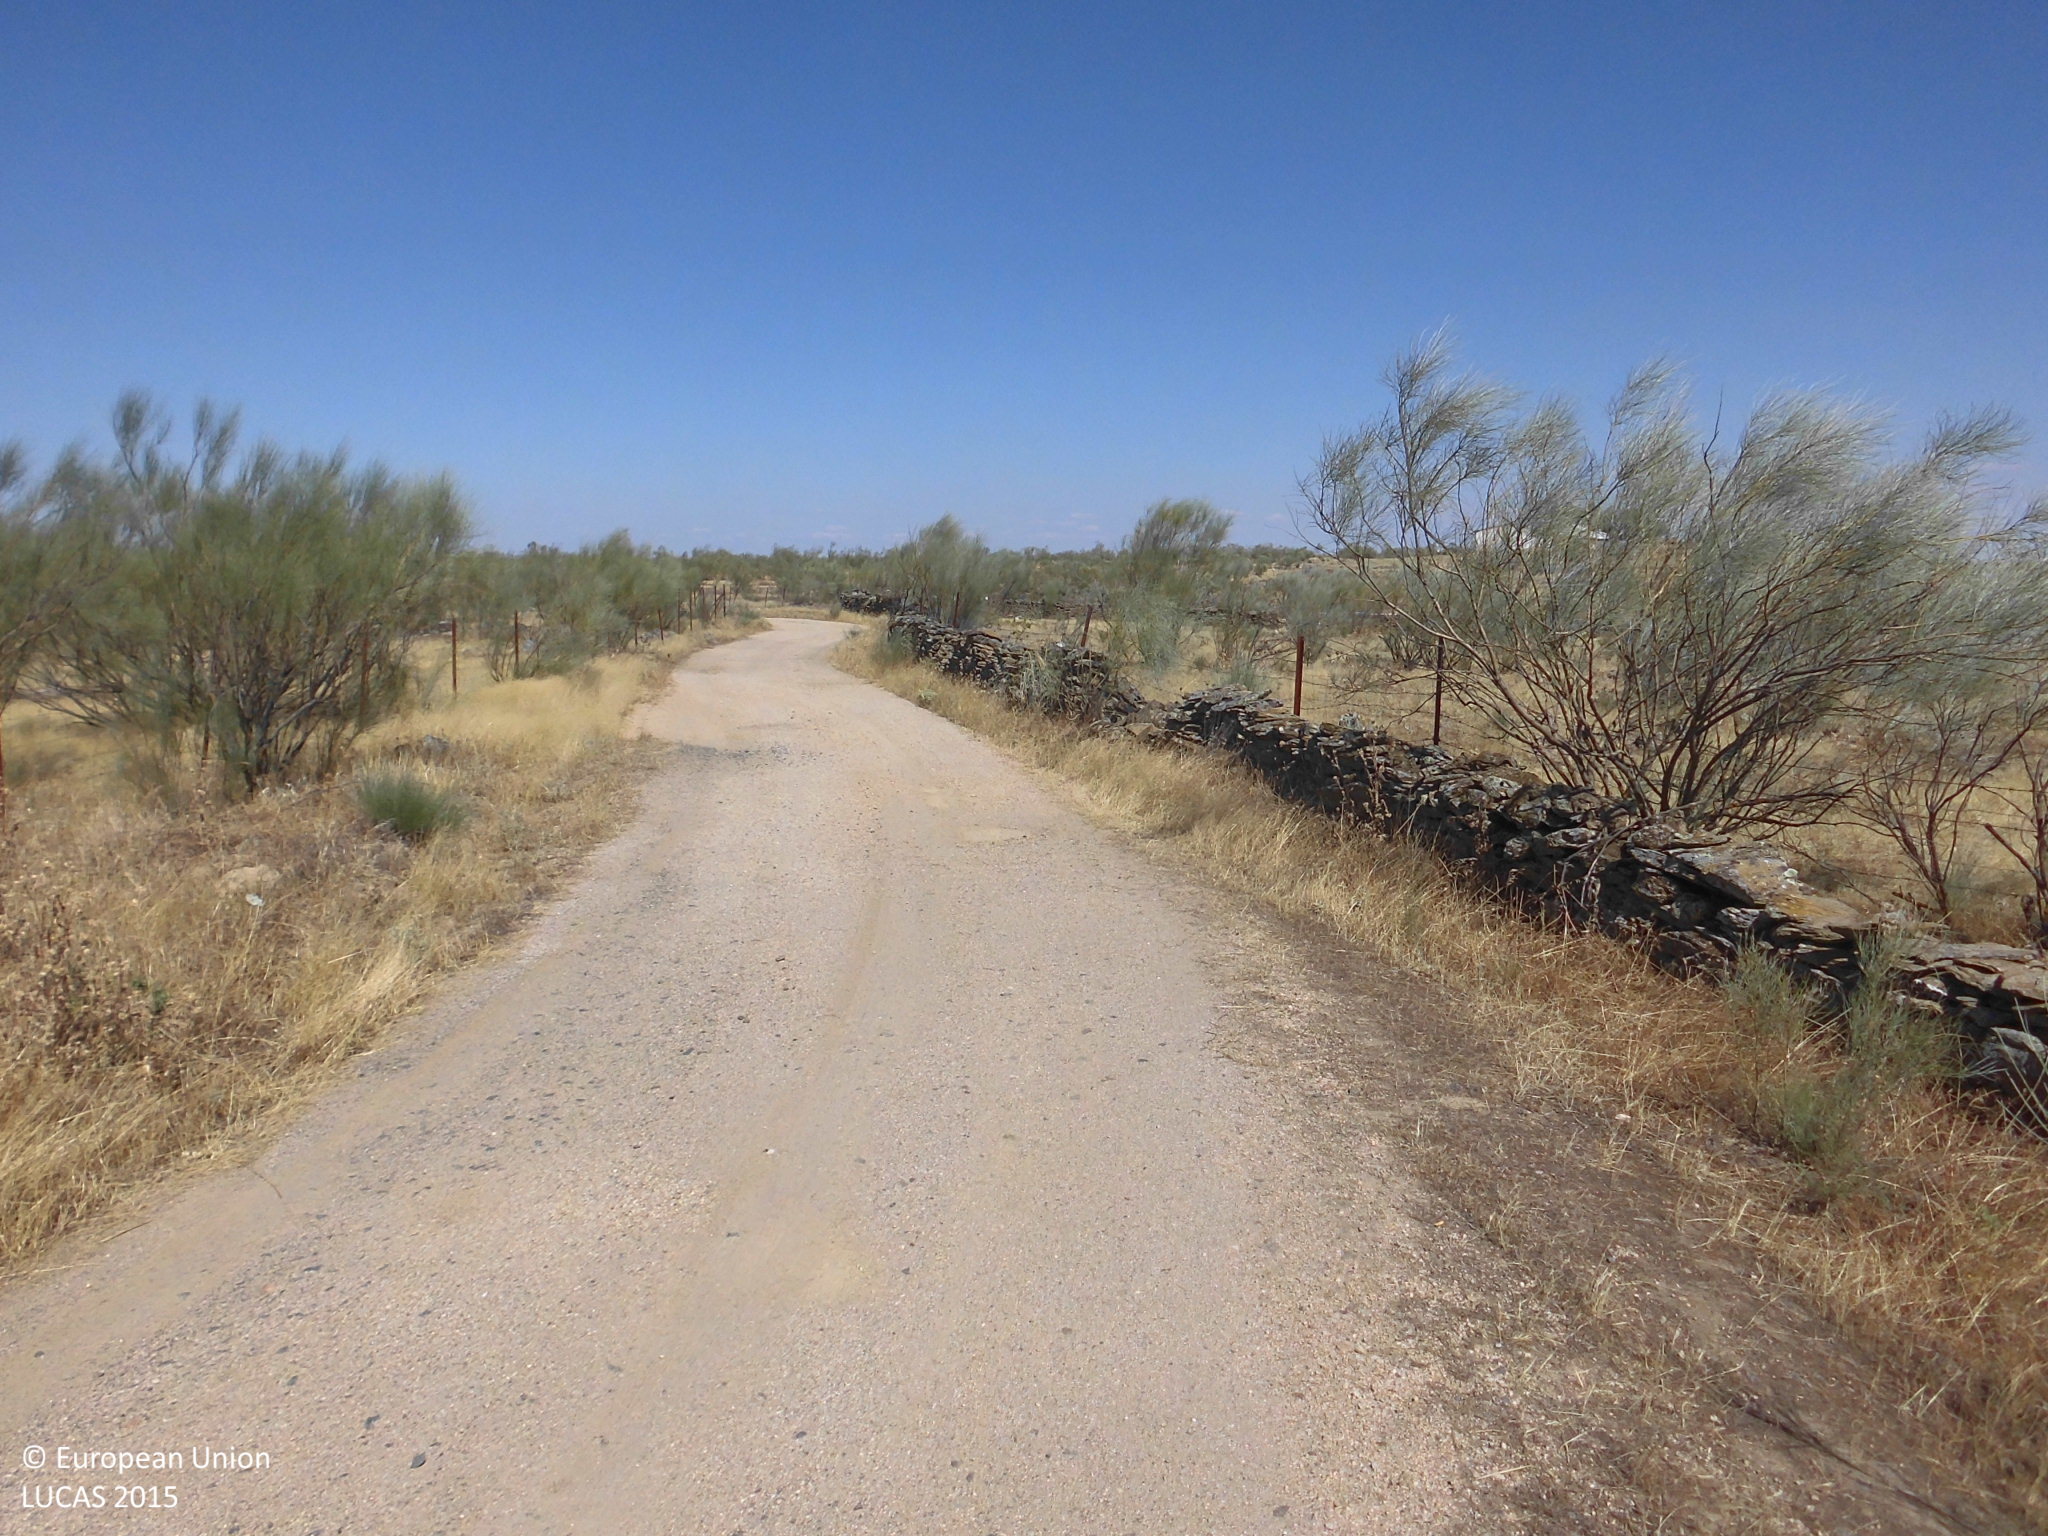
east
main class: Shrubland
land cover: Shrubland without tree cover
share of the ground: 10 - 25 %
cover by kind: herbaceous plants 80 %, shrubs 20 %
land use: Agriculture (excluding fallow land and kitchen gardens)
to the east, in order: Shrubland without tree cover
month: June
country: ES
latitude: 39.6642
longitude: -6.4262
